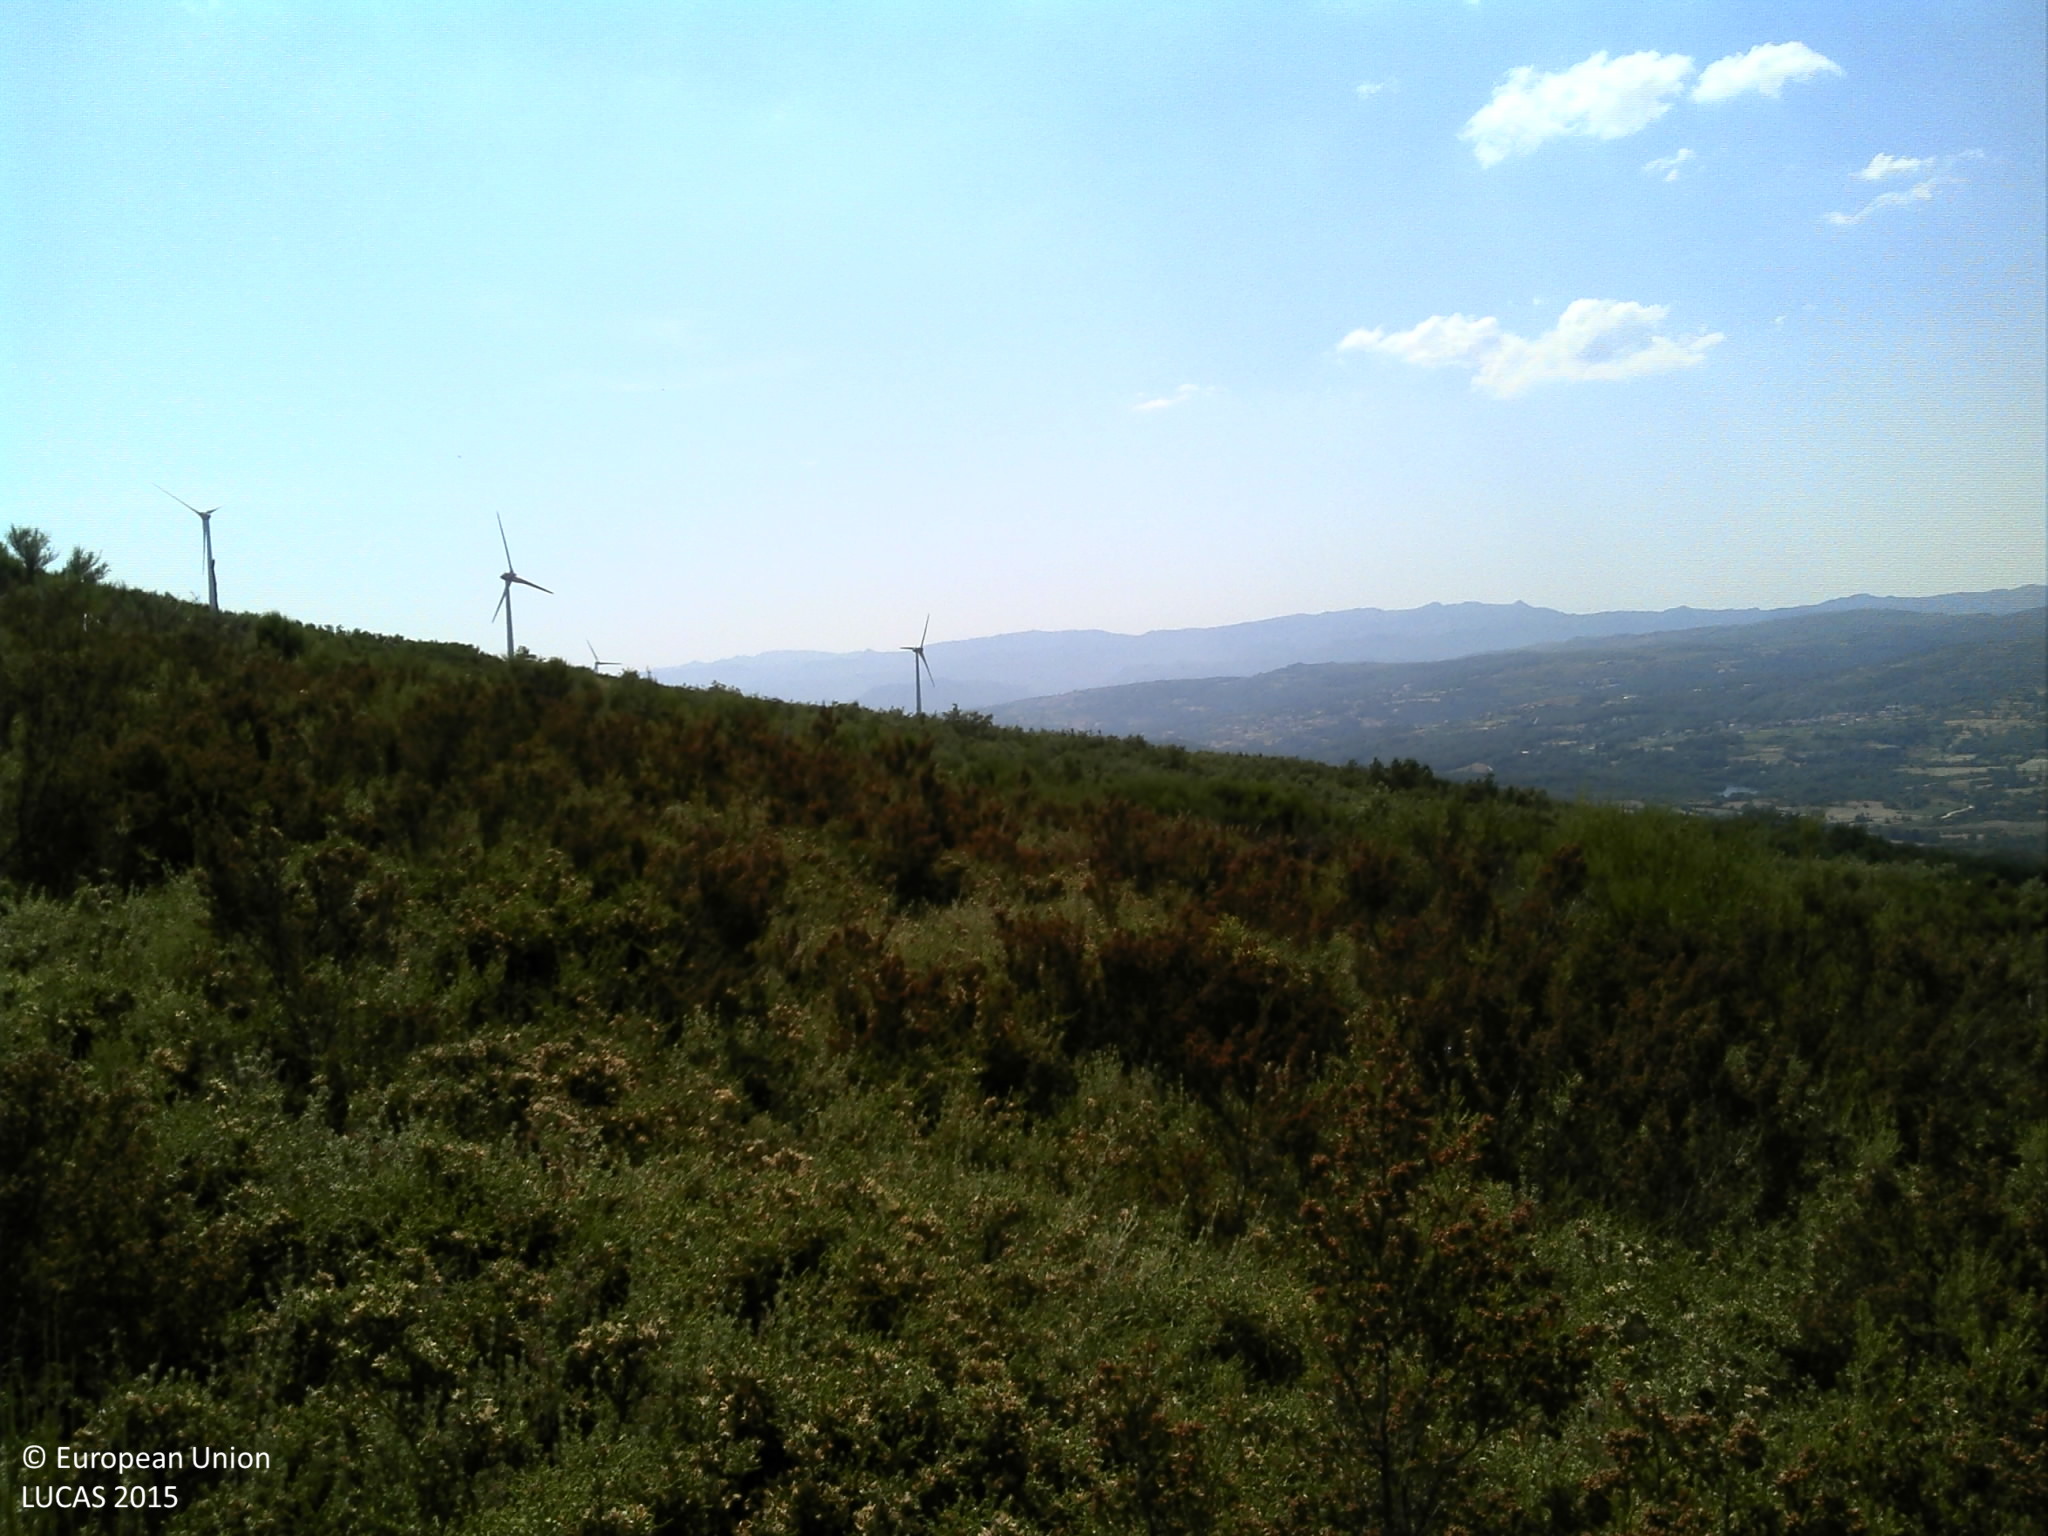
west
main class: Shrubland
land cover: Shrubland without tree cover
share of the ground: > 75 %
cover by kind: shrubs 90 %, consolidated bare surface 5 %, unconsolidated bare surface 5 %
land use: Semi-natural and natural areas not in use
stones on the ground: < 10 %
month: July
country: PT
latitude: 41.7968
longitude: -7.8193
